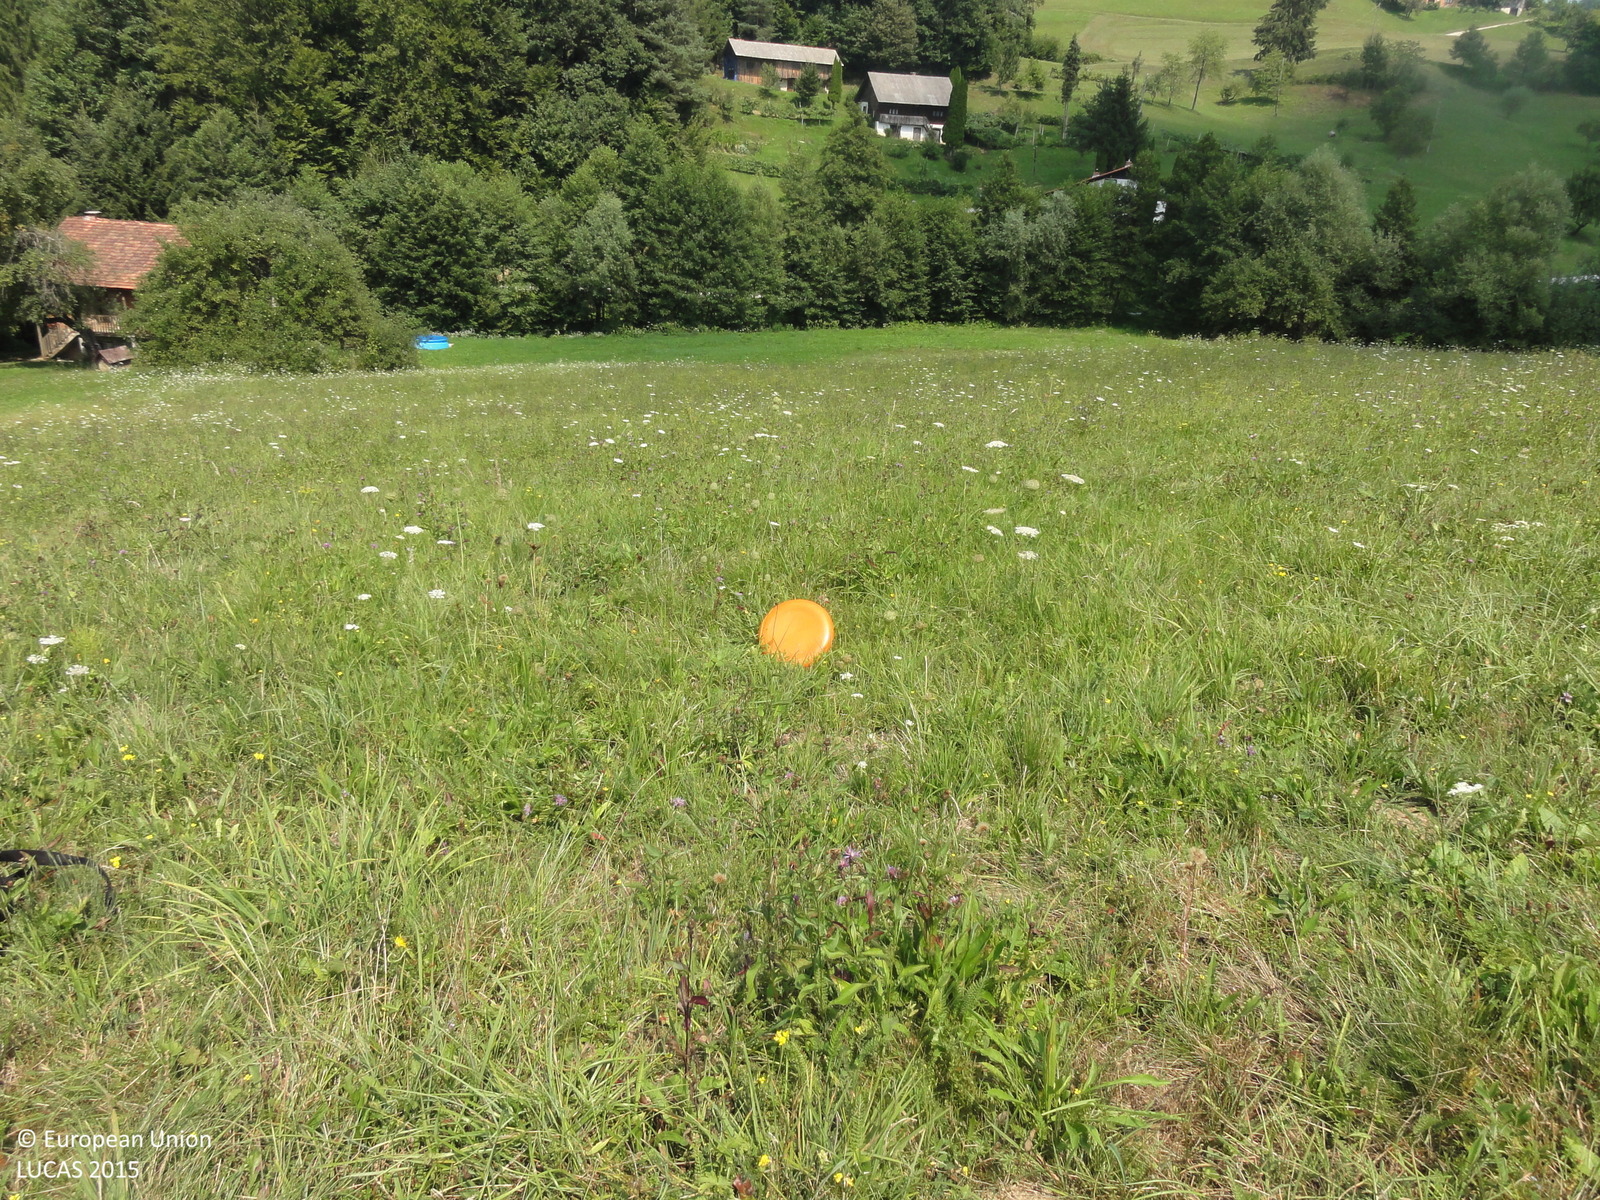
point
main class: Grassland
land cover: Grassland without tree/shrub cover
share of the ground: > 75 %
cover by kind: herbaceous plants 100 %
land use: Agriculture (excluding fallow land and kitchen gardens)
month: August
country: SI
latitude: 46.1375
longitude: 15.4992
